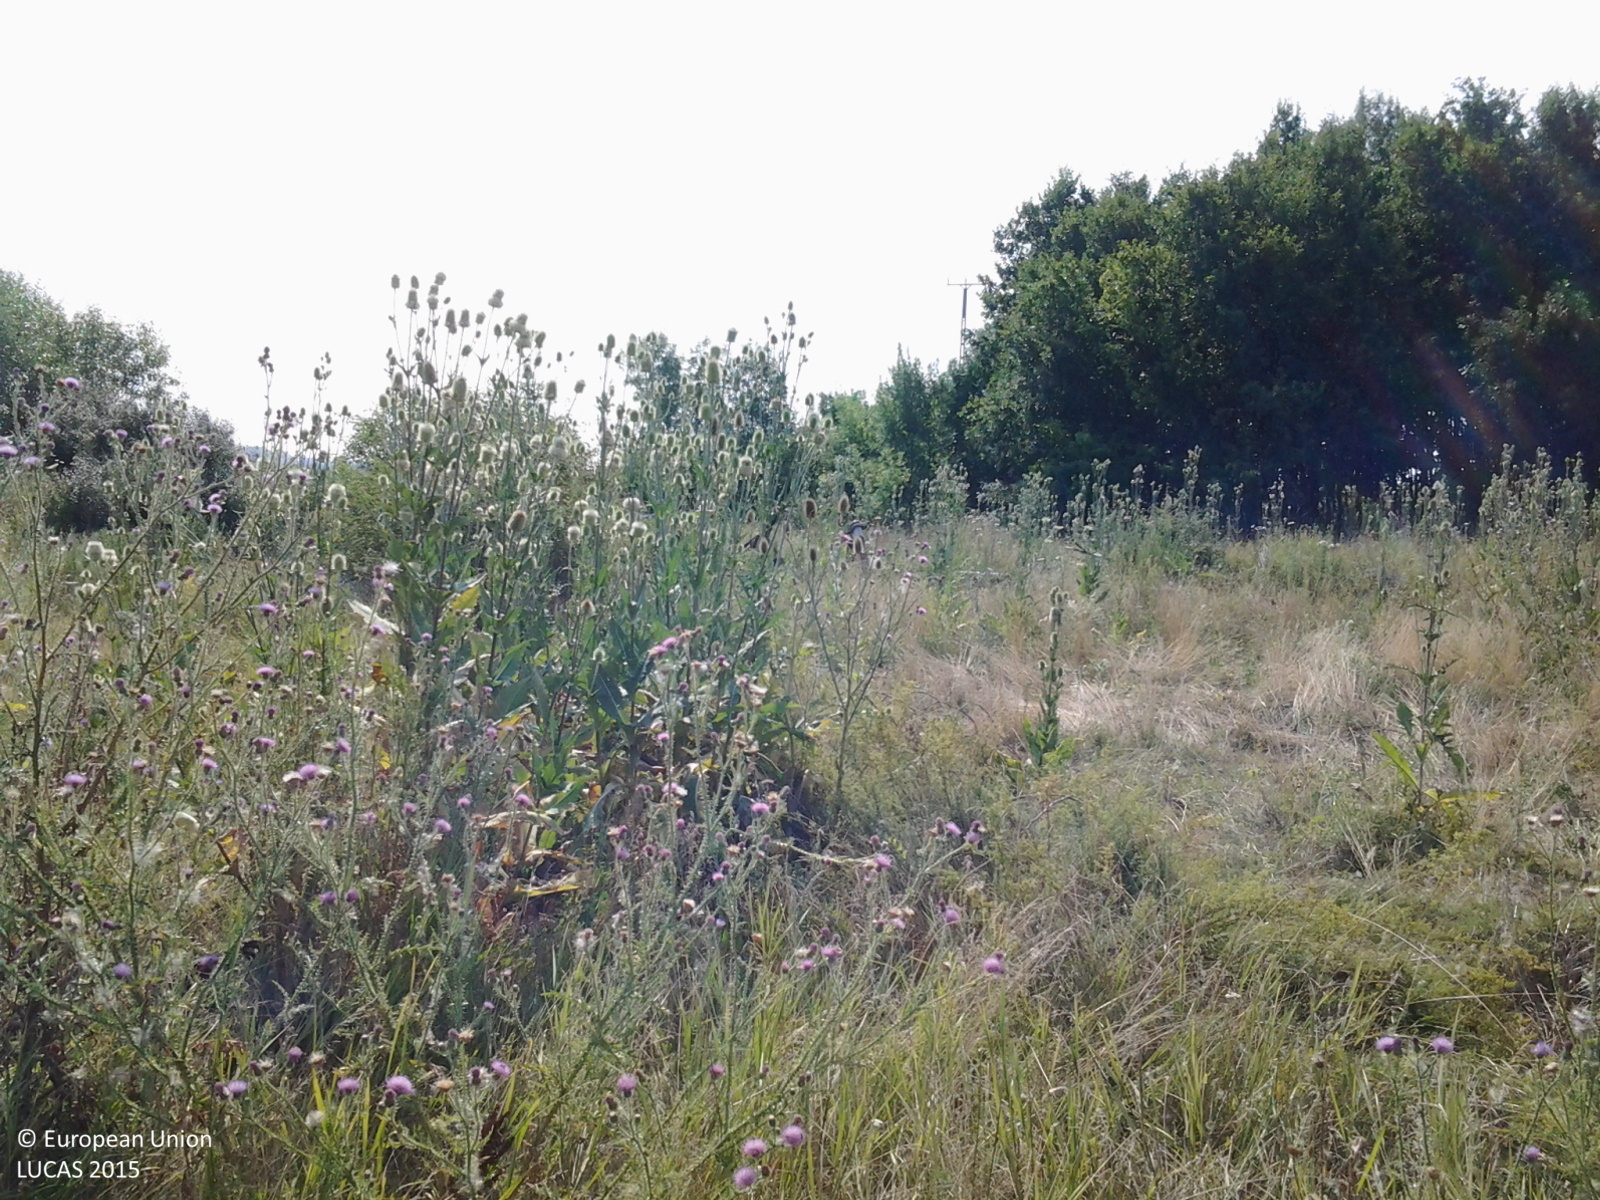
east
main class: Grassland
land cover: Grassland without tree/shrub cover
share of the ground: > 75 %
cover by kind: herbaceous plants 100 %
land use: Agriculture (excluding fallow land and kitchen gardens)
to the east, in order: Grassland without tree/shrub cover; Electric lines; Ditches and canals; Groves; Grassland without tree/shrub cover
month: July
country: HU
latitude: 46.7916
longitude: 21.4226
